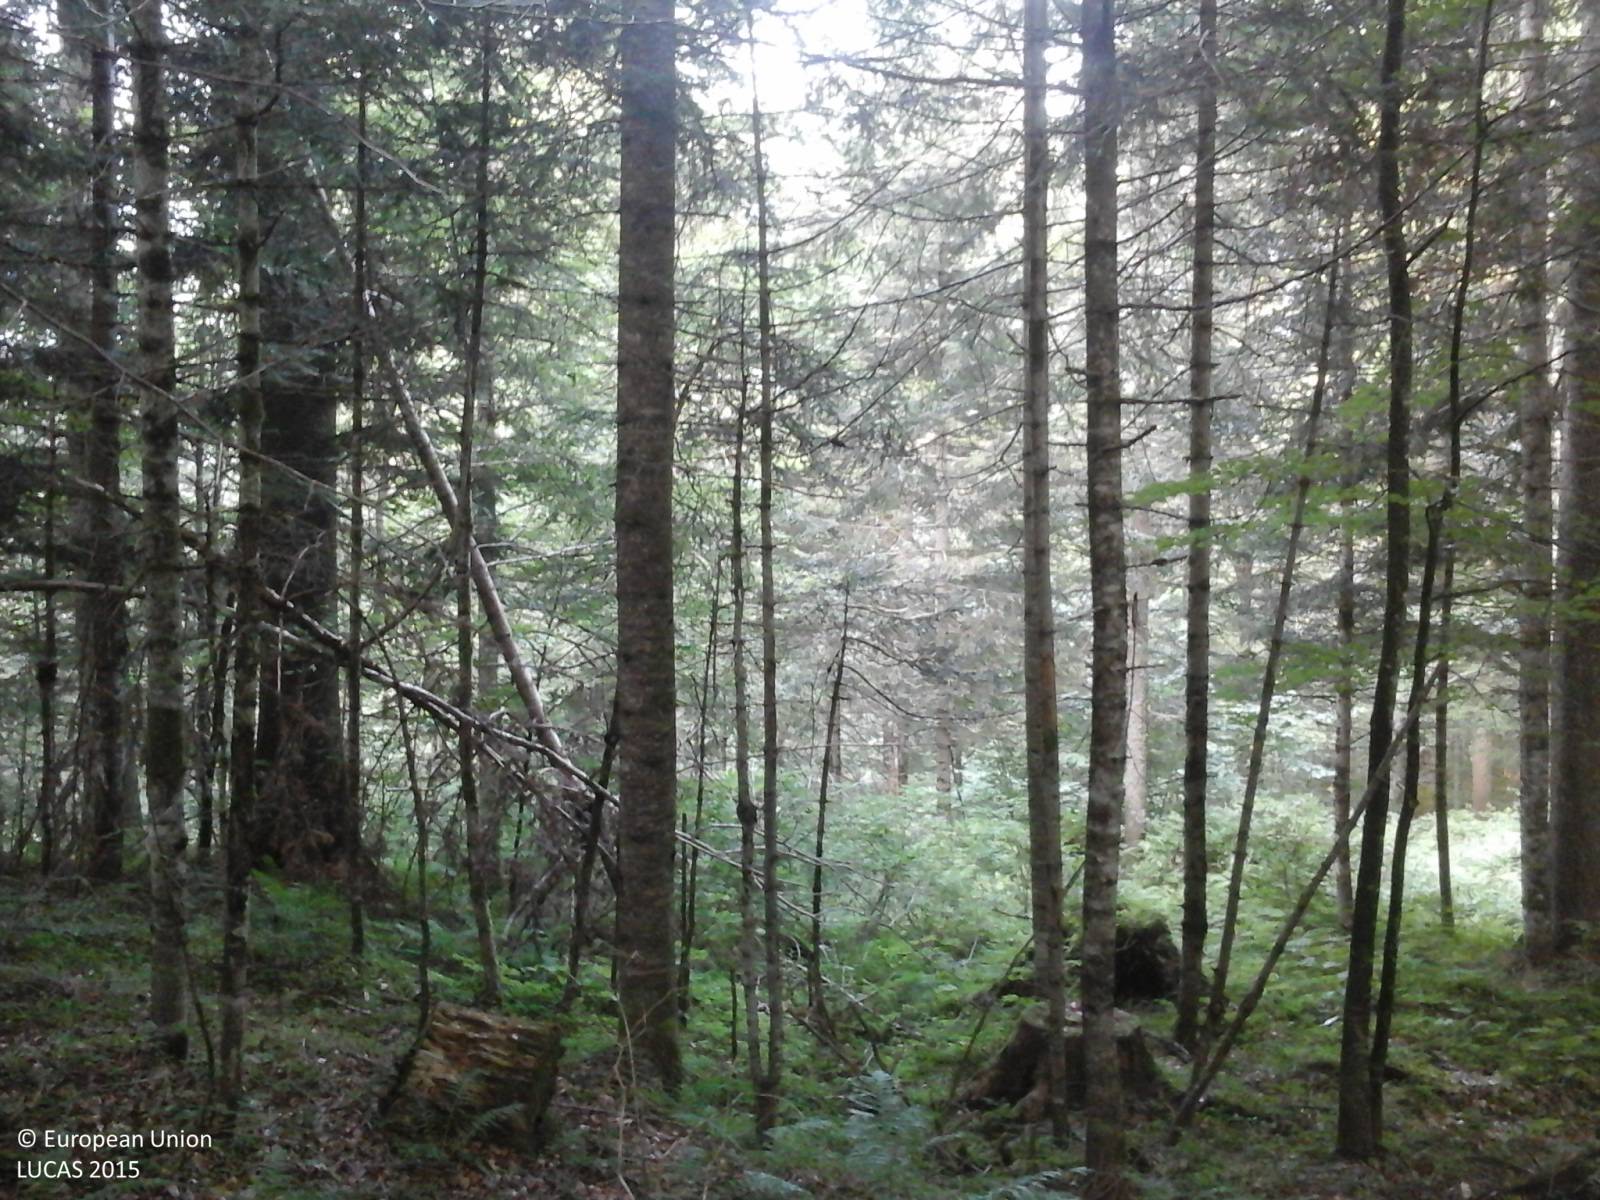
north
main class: Woodland
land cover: Spruce dominated mixed woodland
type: alpine coniferous forest
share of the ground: > 75 %
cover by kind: coniferous forest trees 65 %, broadleaved forest trees 30 %, herbaceous plants 5 %
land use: Forestry
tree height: > 5 m
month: July
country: IT
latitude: 46.4428
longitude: 12.7176
